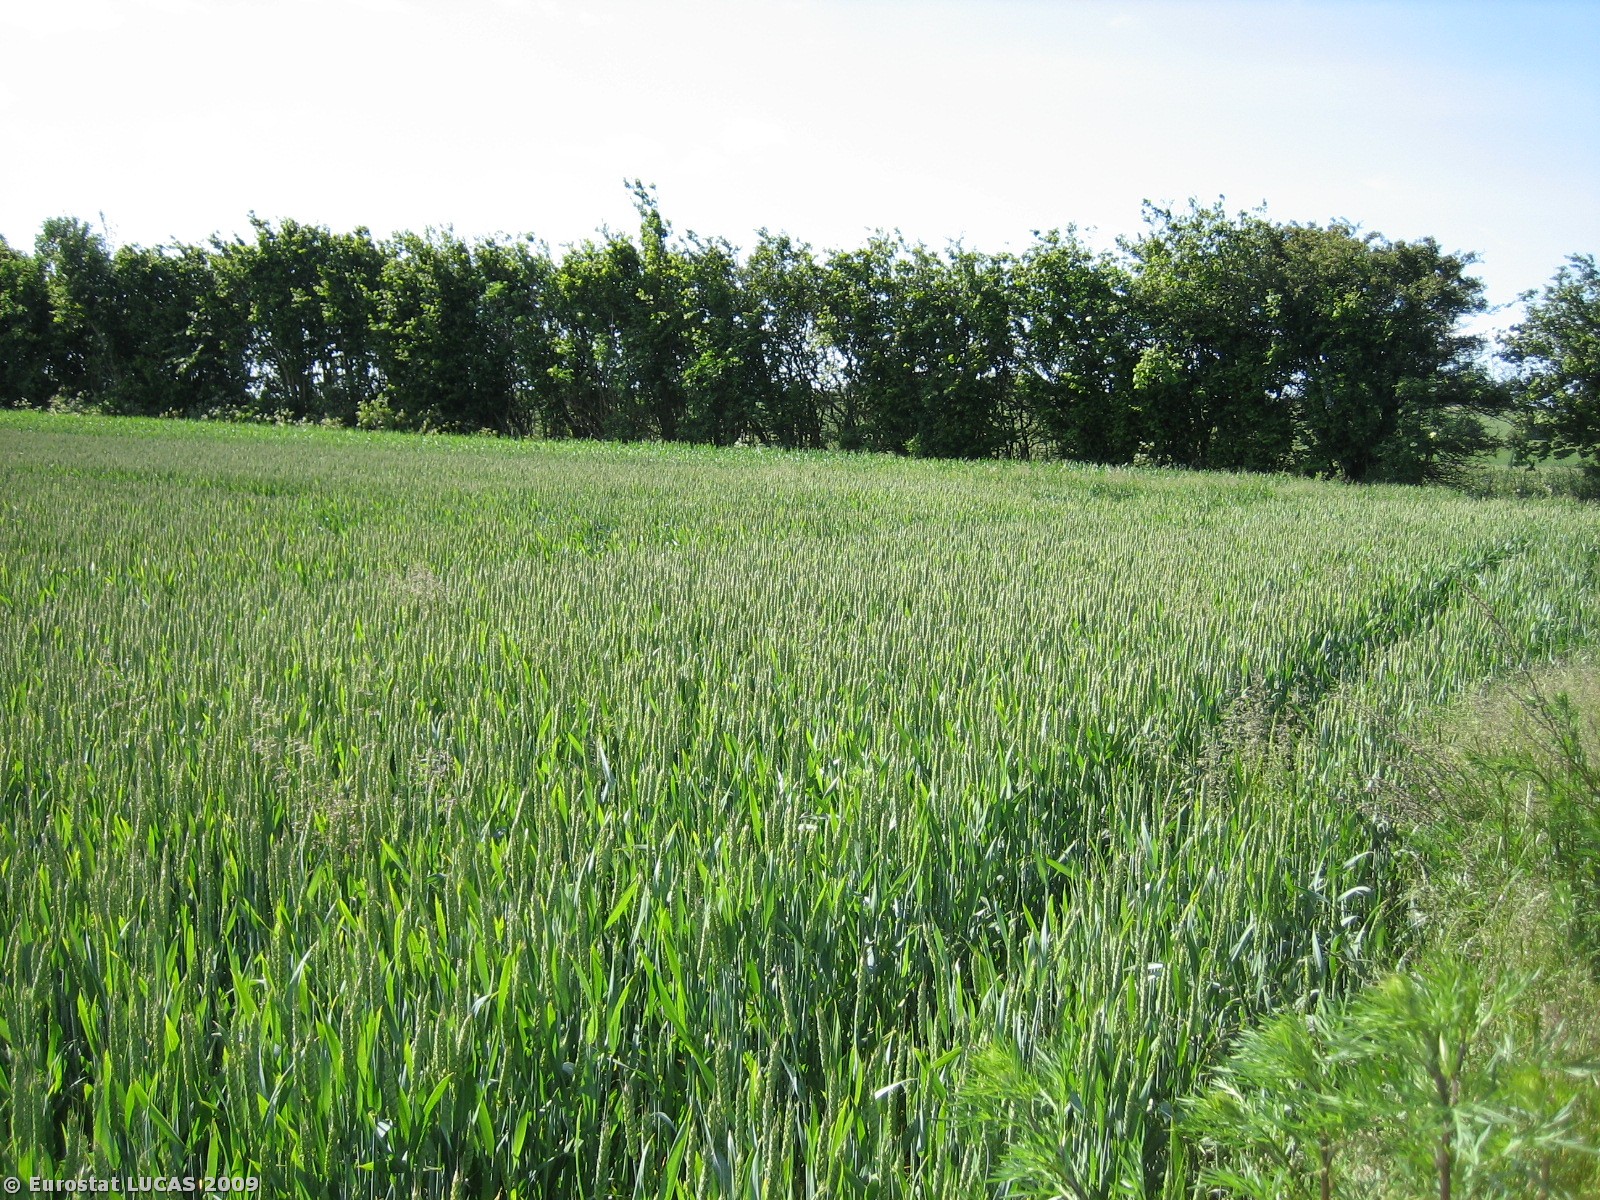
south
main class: Cropland
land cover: Common wheat
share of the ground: > 75 %
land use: Agriculture (excluding fallow land and kitchen gardens)
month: June
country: DK
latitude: 55.7563
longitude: 9.8886
